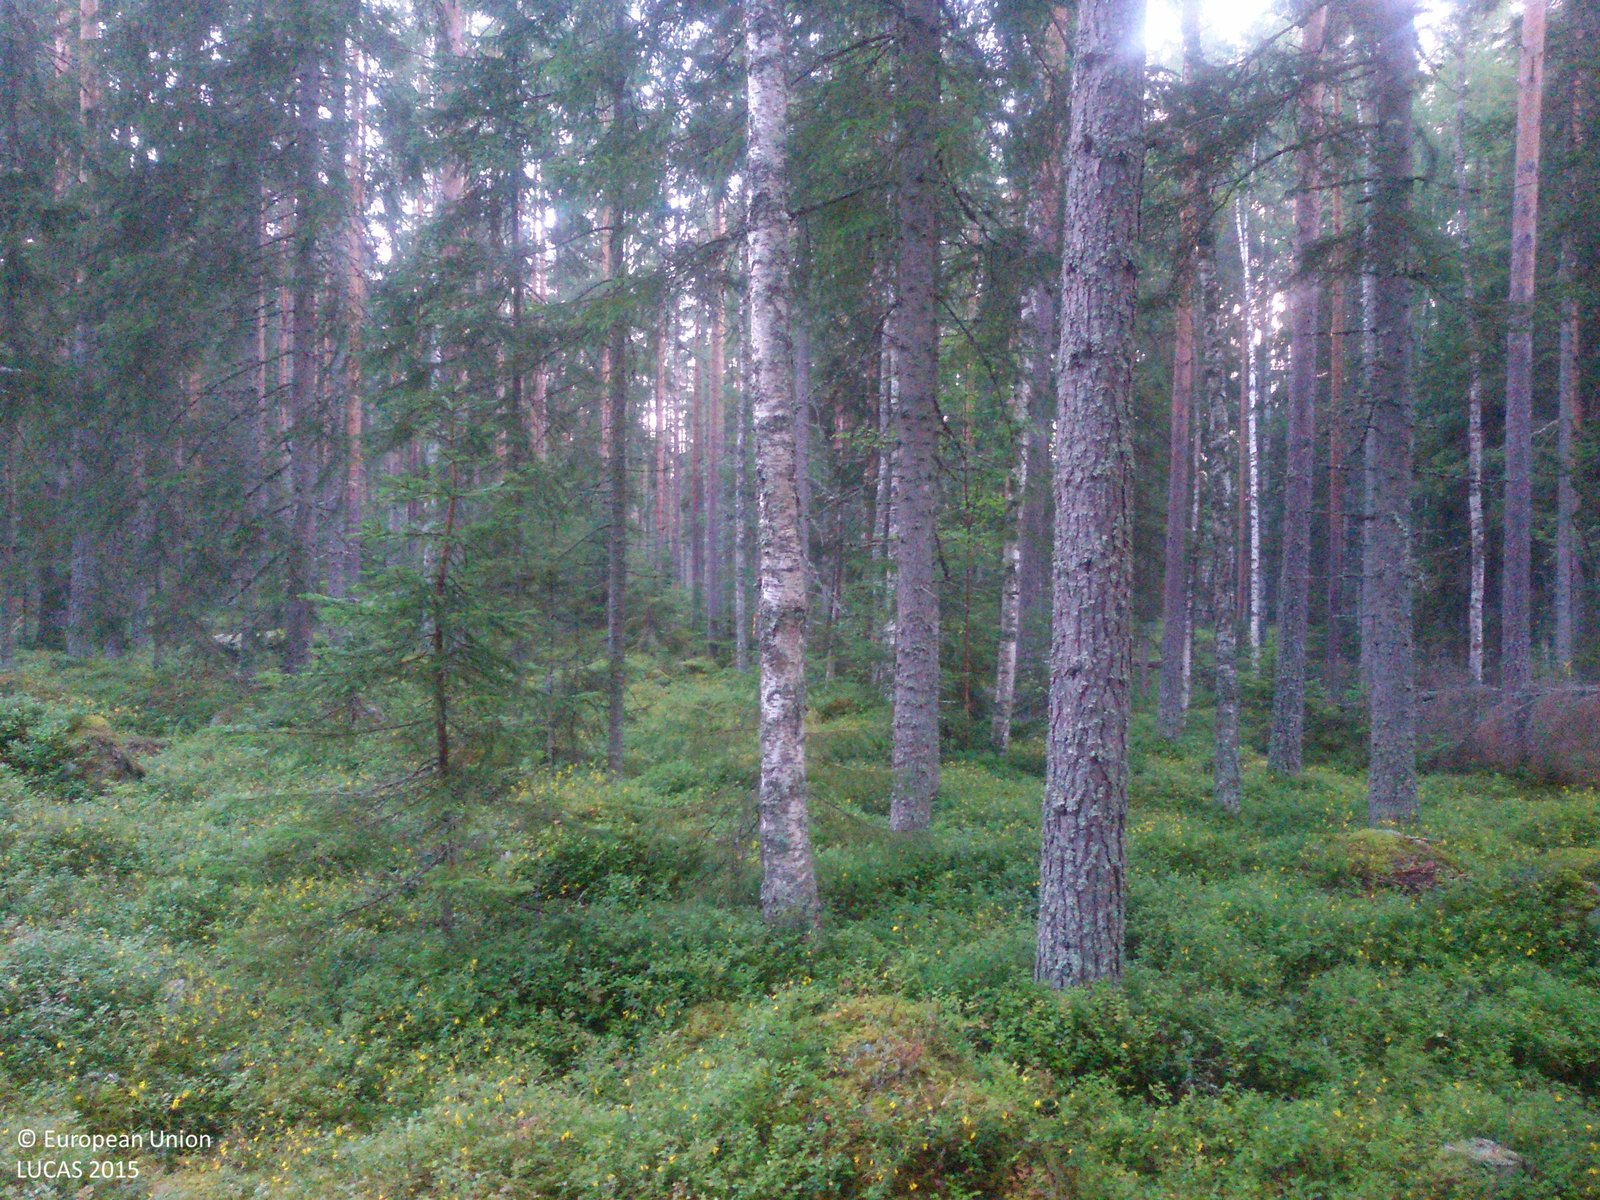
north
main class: Woodland
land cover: Other coniferous woodland
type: boreal forest
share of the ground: 50 - 75 %
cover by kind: coniferous forest trees 55 %, broadleaved forest trees 15 %, shrubs 15 %, lichens and mosses 10 %, herbaceous plants 5 %
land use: Forestry
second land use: Sport
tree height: > 5 m
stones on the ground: > 50 %
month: August
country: SE
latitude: 60.7991
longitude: 16.6944
